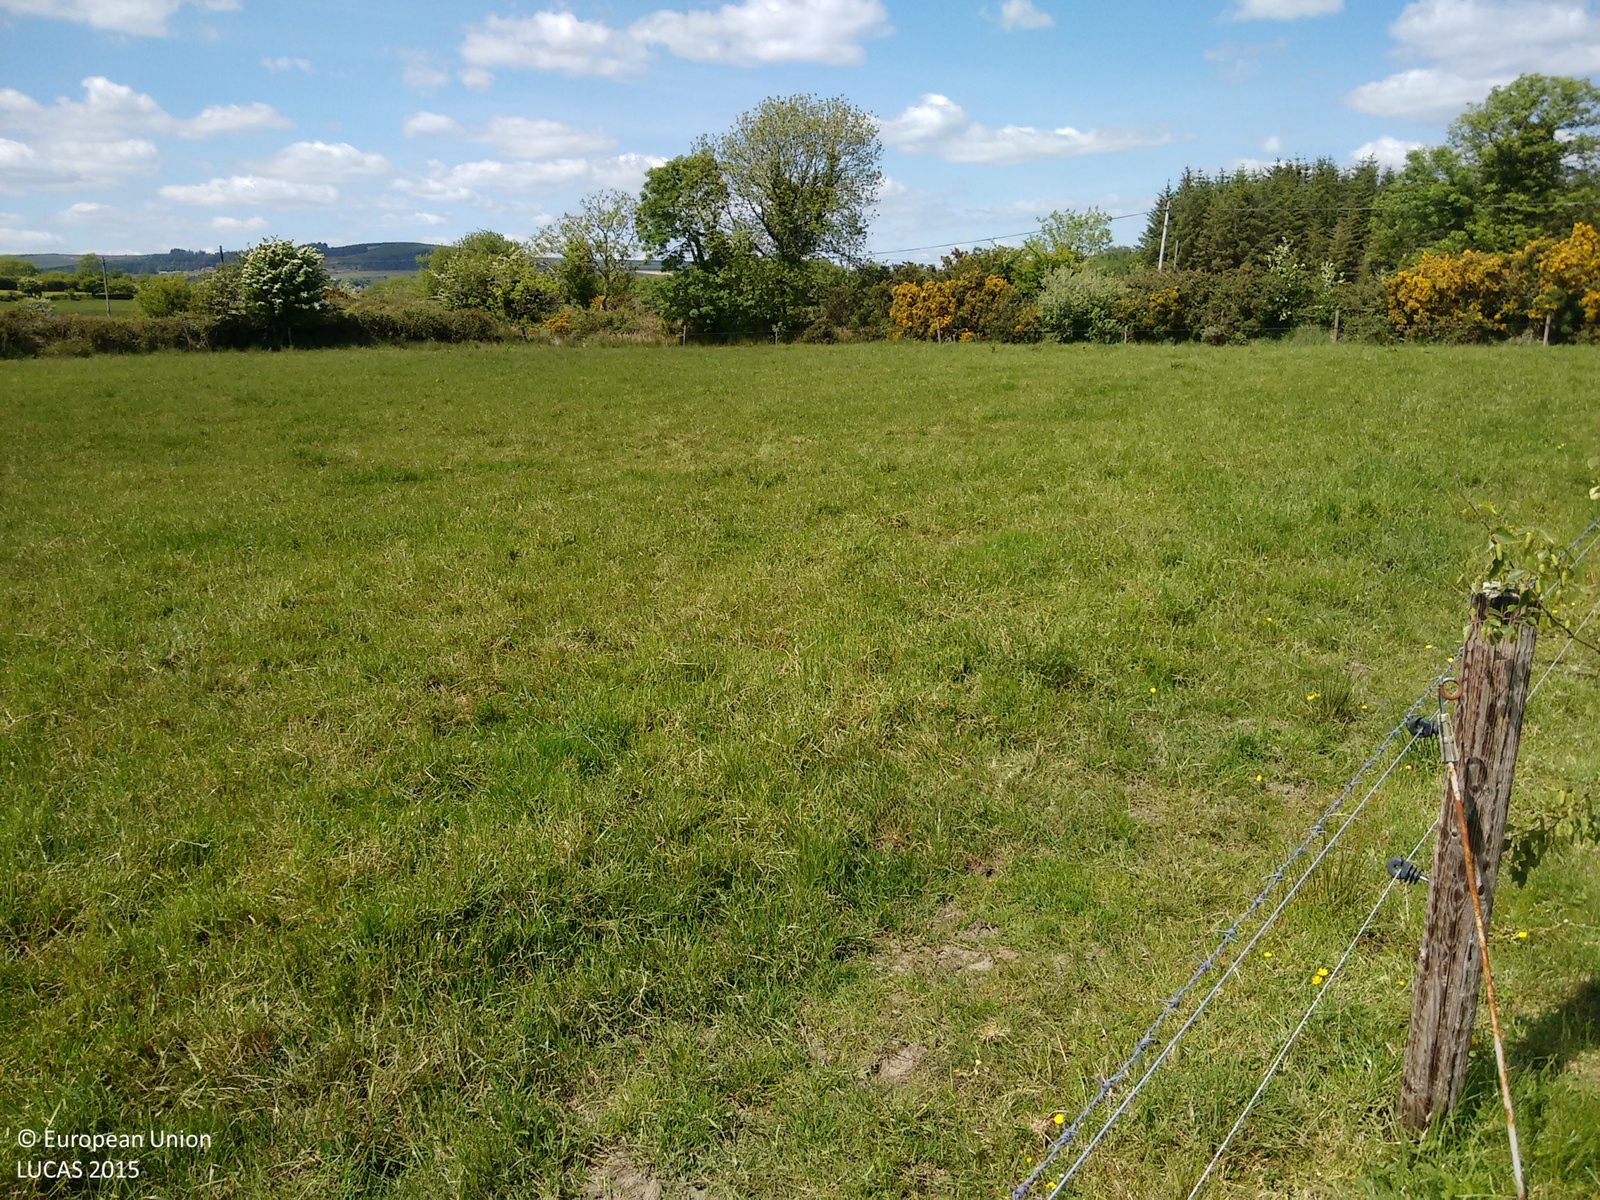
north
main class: Grassland
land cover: Grassland without tree/shrub cover
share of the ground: > 75 %
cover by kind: herbaceous plants 95 %, shrubs 5 %
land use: Agriculture (excluding fallow land and kitchen gardens)
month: June
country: IE
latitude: 51.9785
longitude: -8.8270
